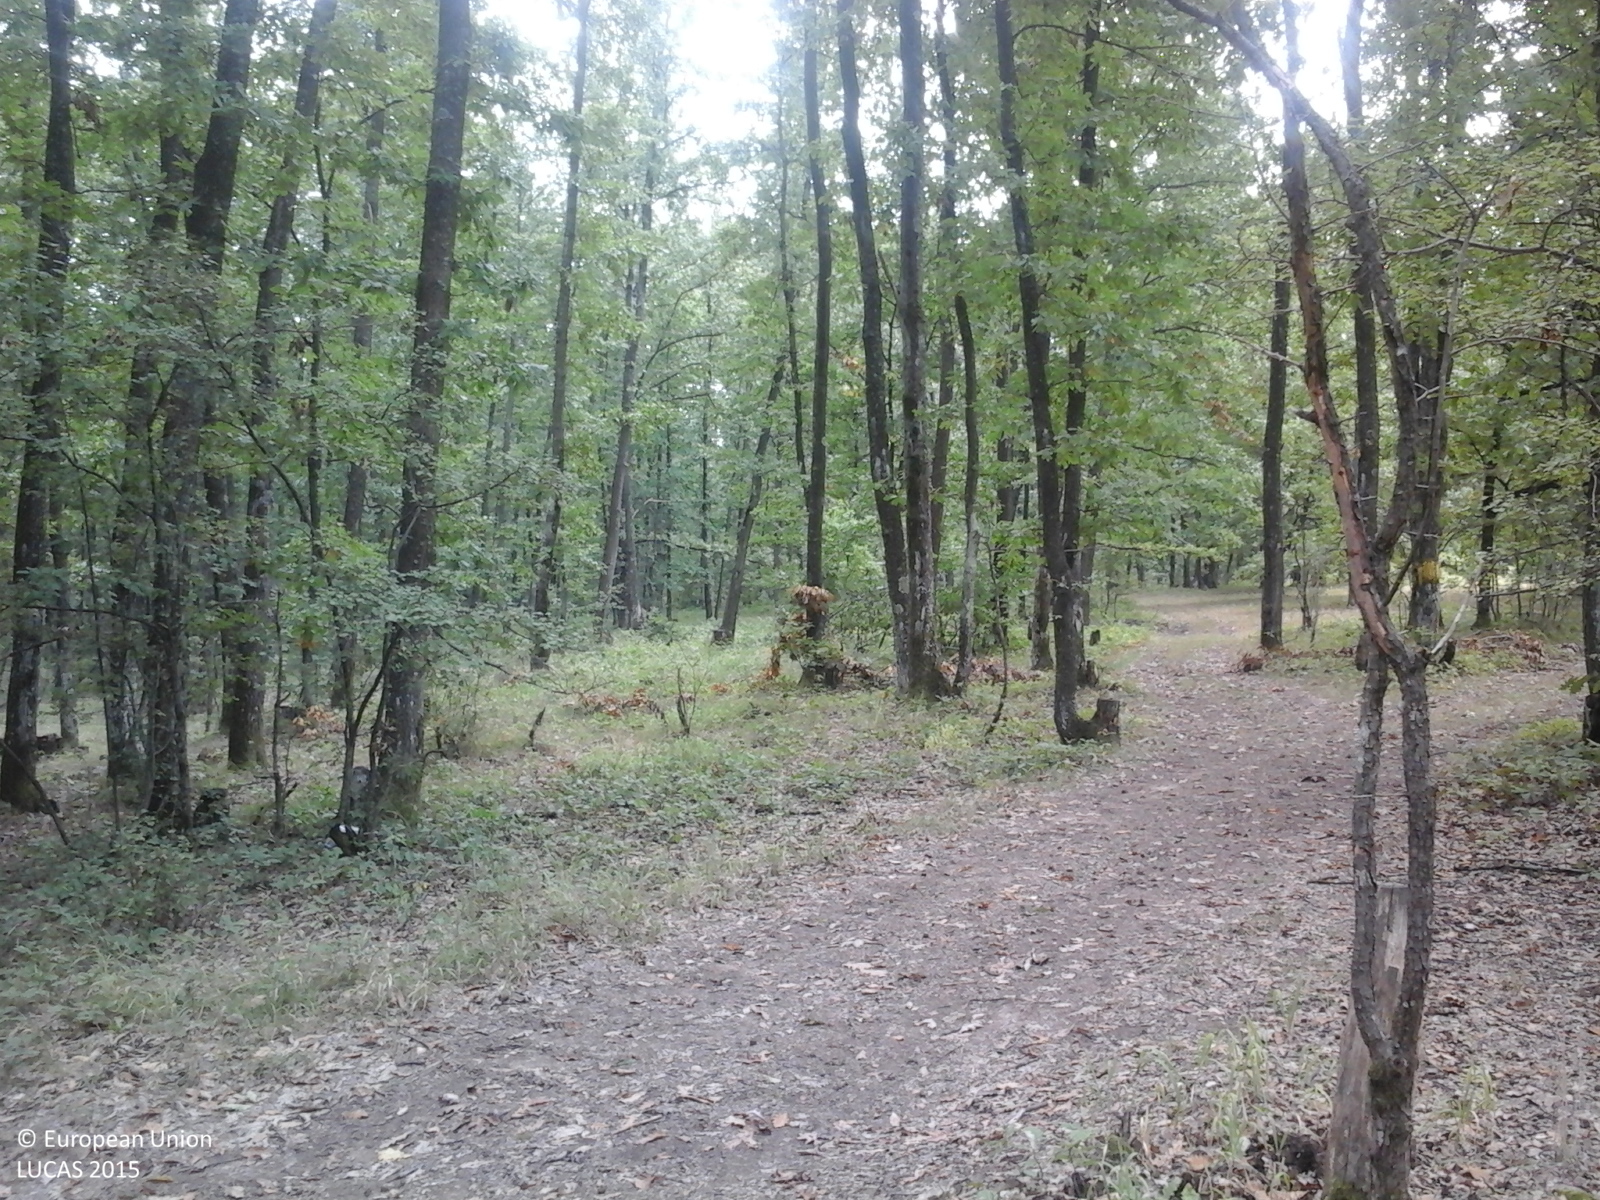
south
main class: Woodland
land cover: Broadleaved woodland
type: acidophilous oak and oak-birch forest
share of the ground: > 75 %
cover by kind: broadleaved forest trees 100 %
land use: Forestry
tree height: > 5 m
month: September
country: RO
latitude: 45.0115
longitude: 23.1074
